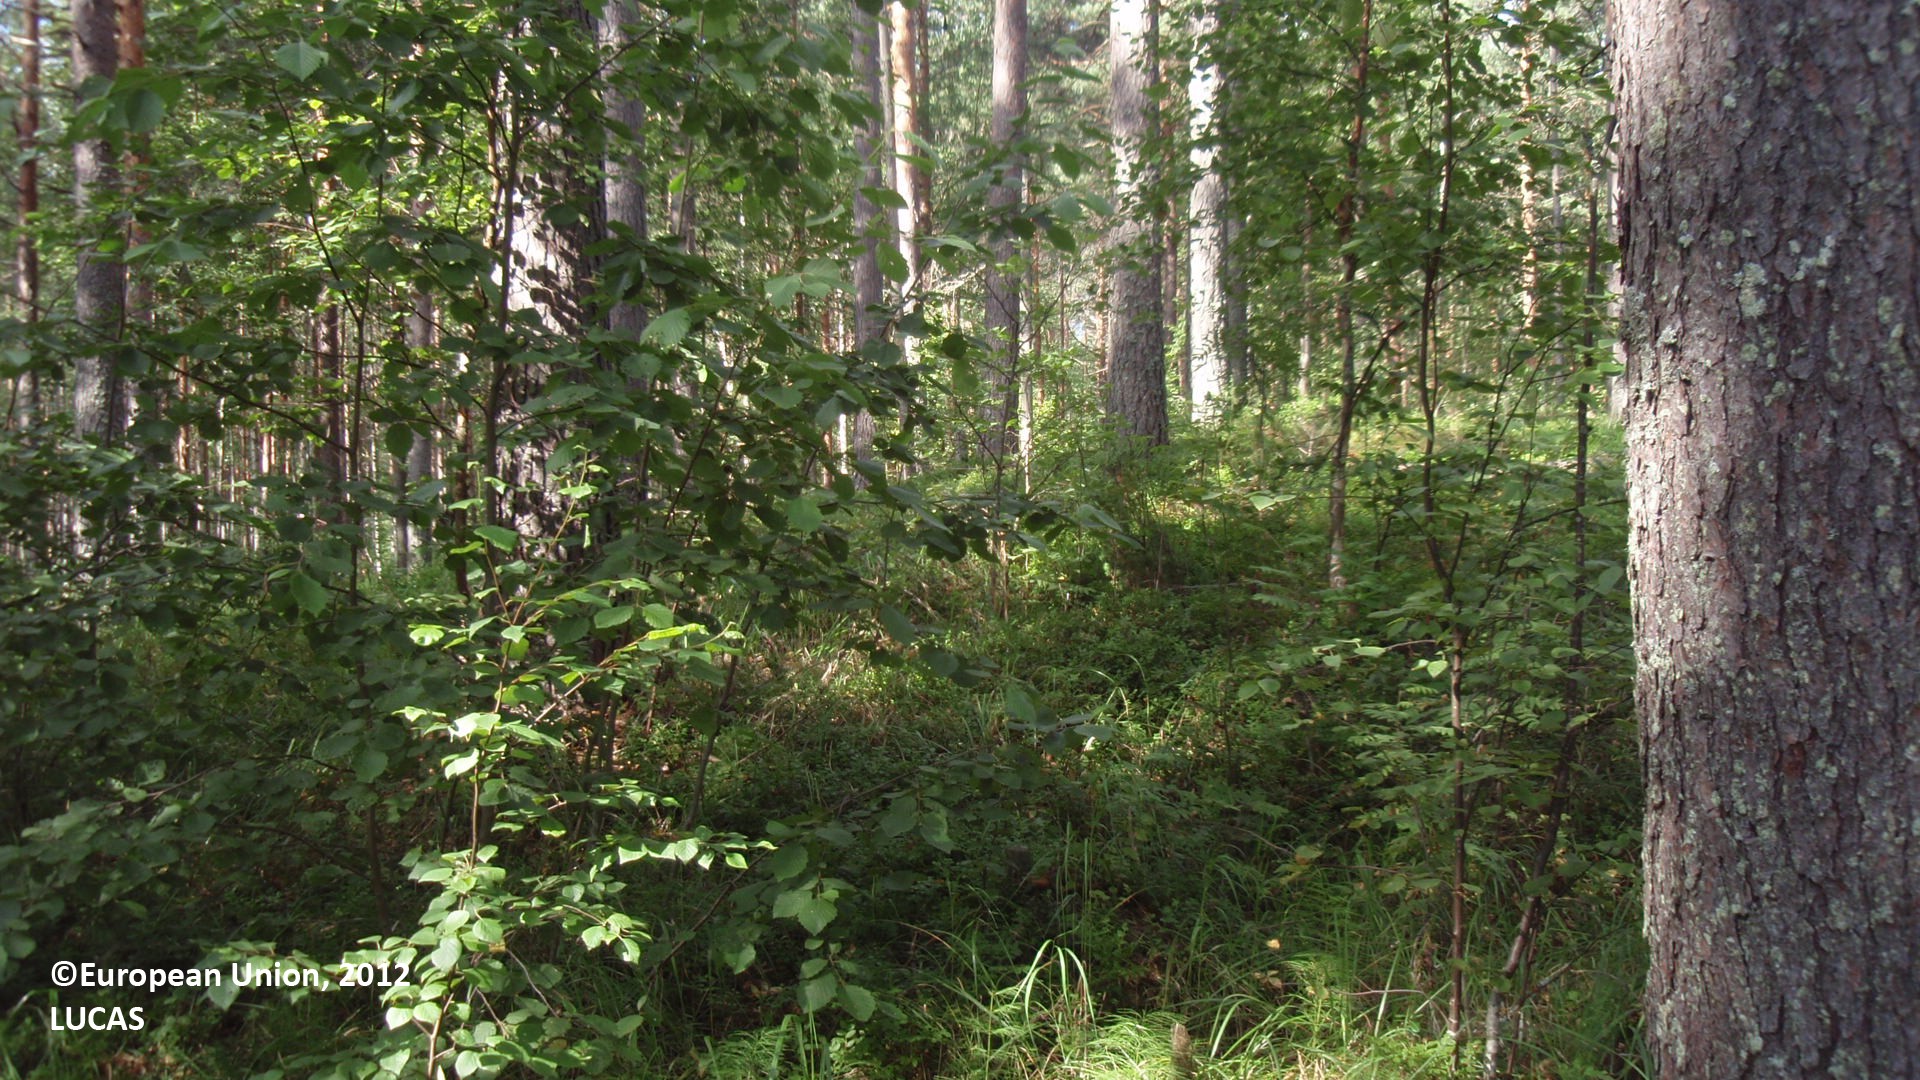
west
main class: Woodland
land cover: Pine dominated mixed woodland
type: boreal forest
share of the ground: 50 - 75 %
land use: Forestry
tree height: > 5 m
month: August
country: FI
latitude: 61.1951
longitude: 28.1565
